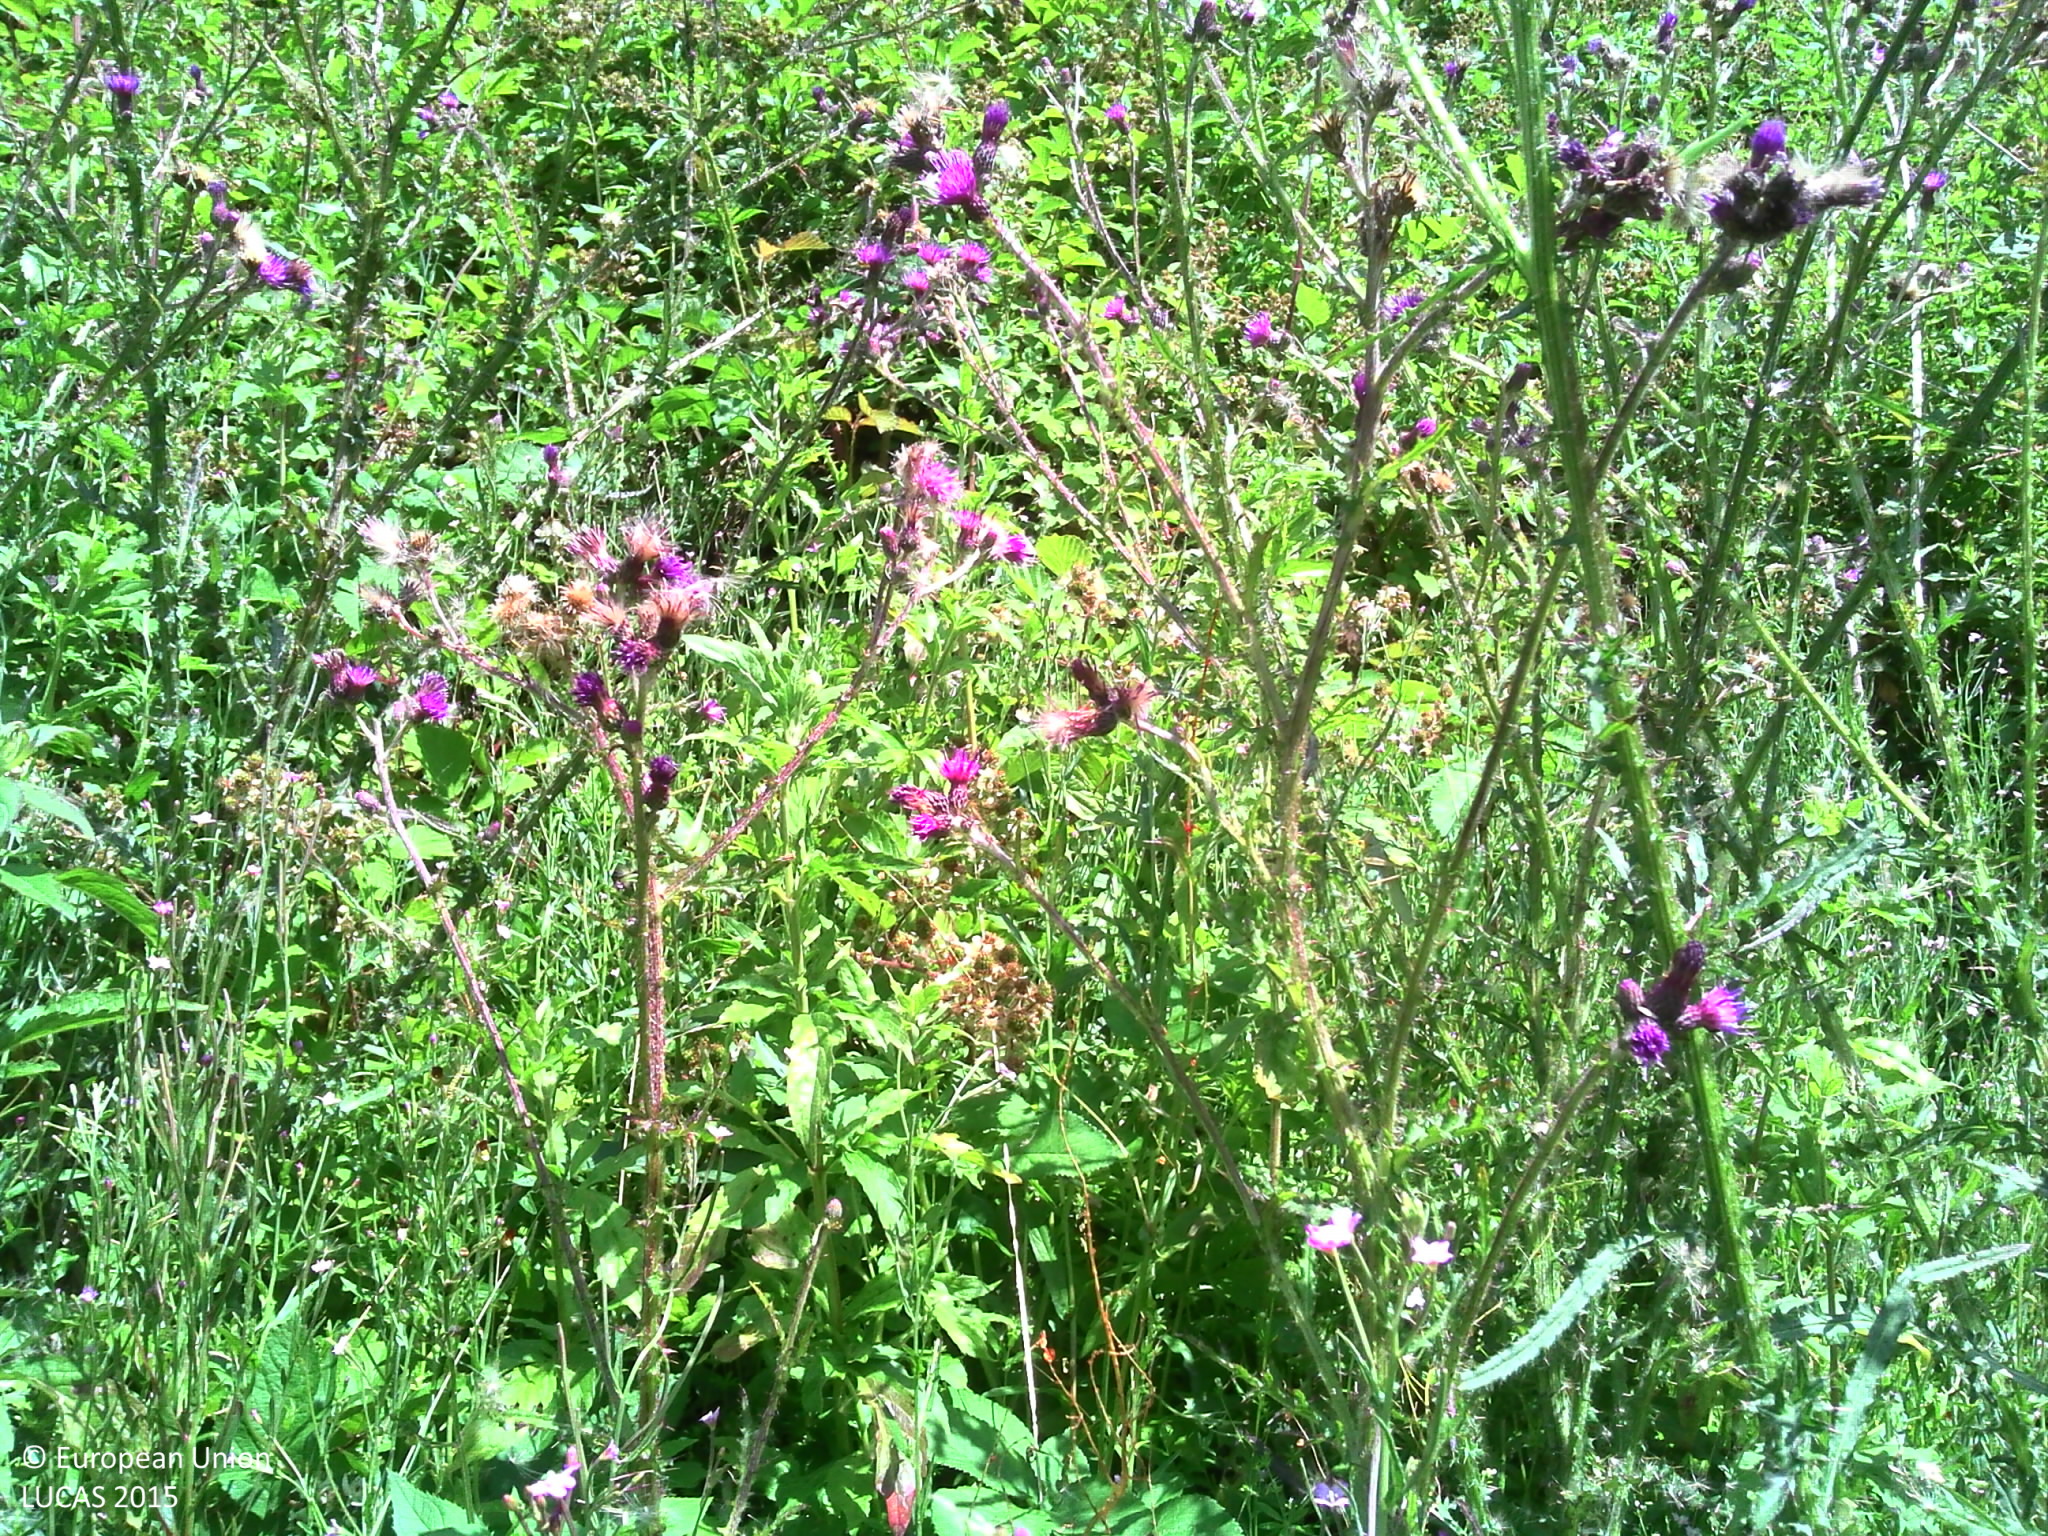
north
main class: Grassland
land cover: Spontaneously vegetated surfaces
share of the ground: > 75 %
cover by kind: herbaceous plants 95 %, shrubs 5 %
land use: Semi-natural and natural areas not in use
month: June
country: FR
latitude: 46.9423
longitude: 4.0218
